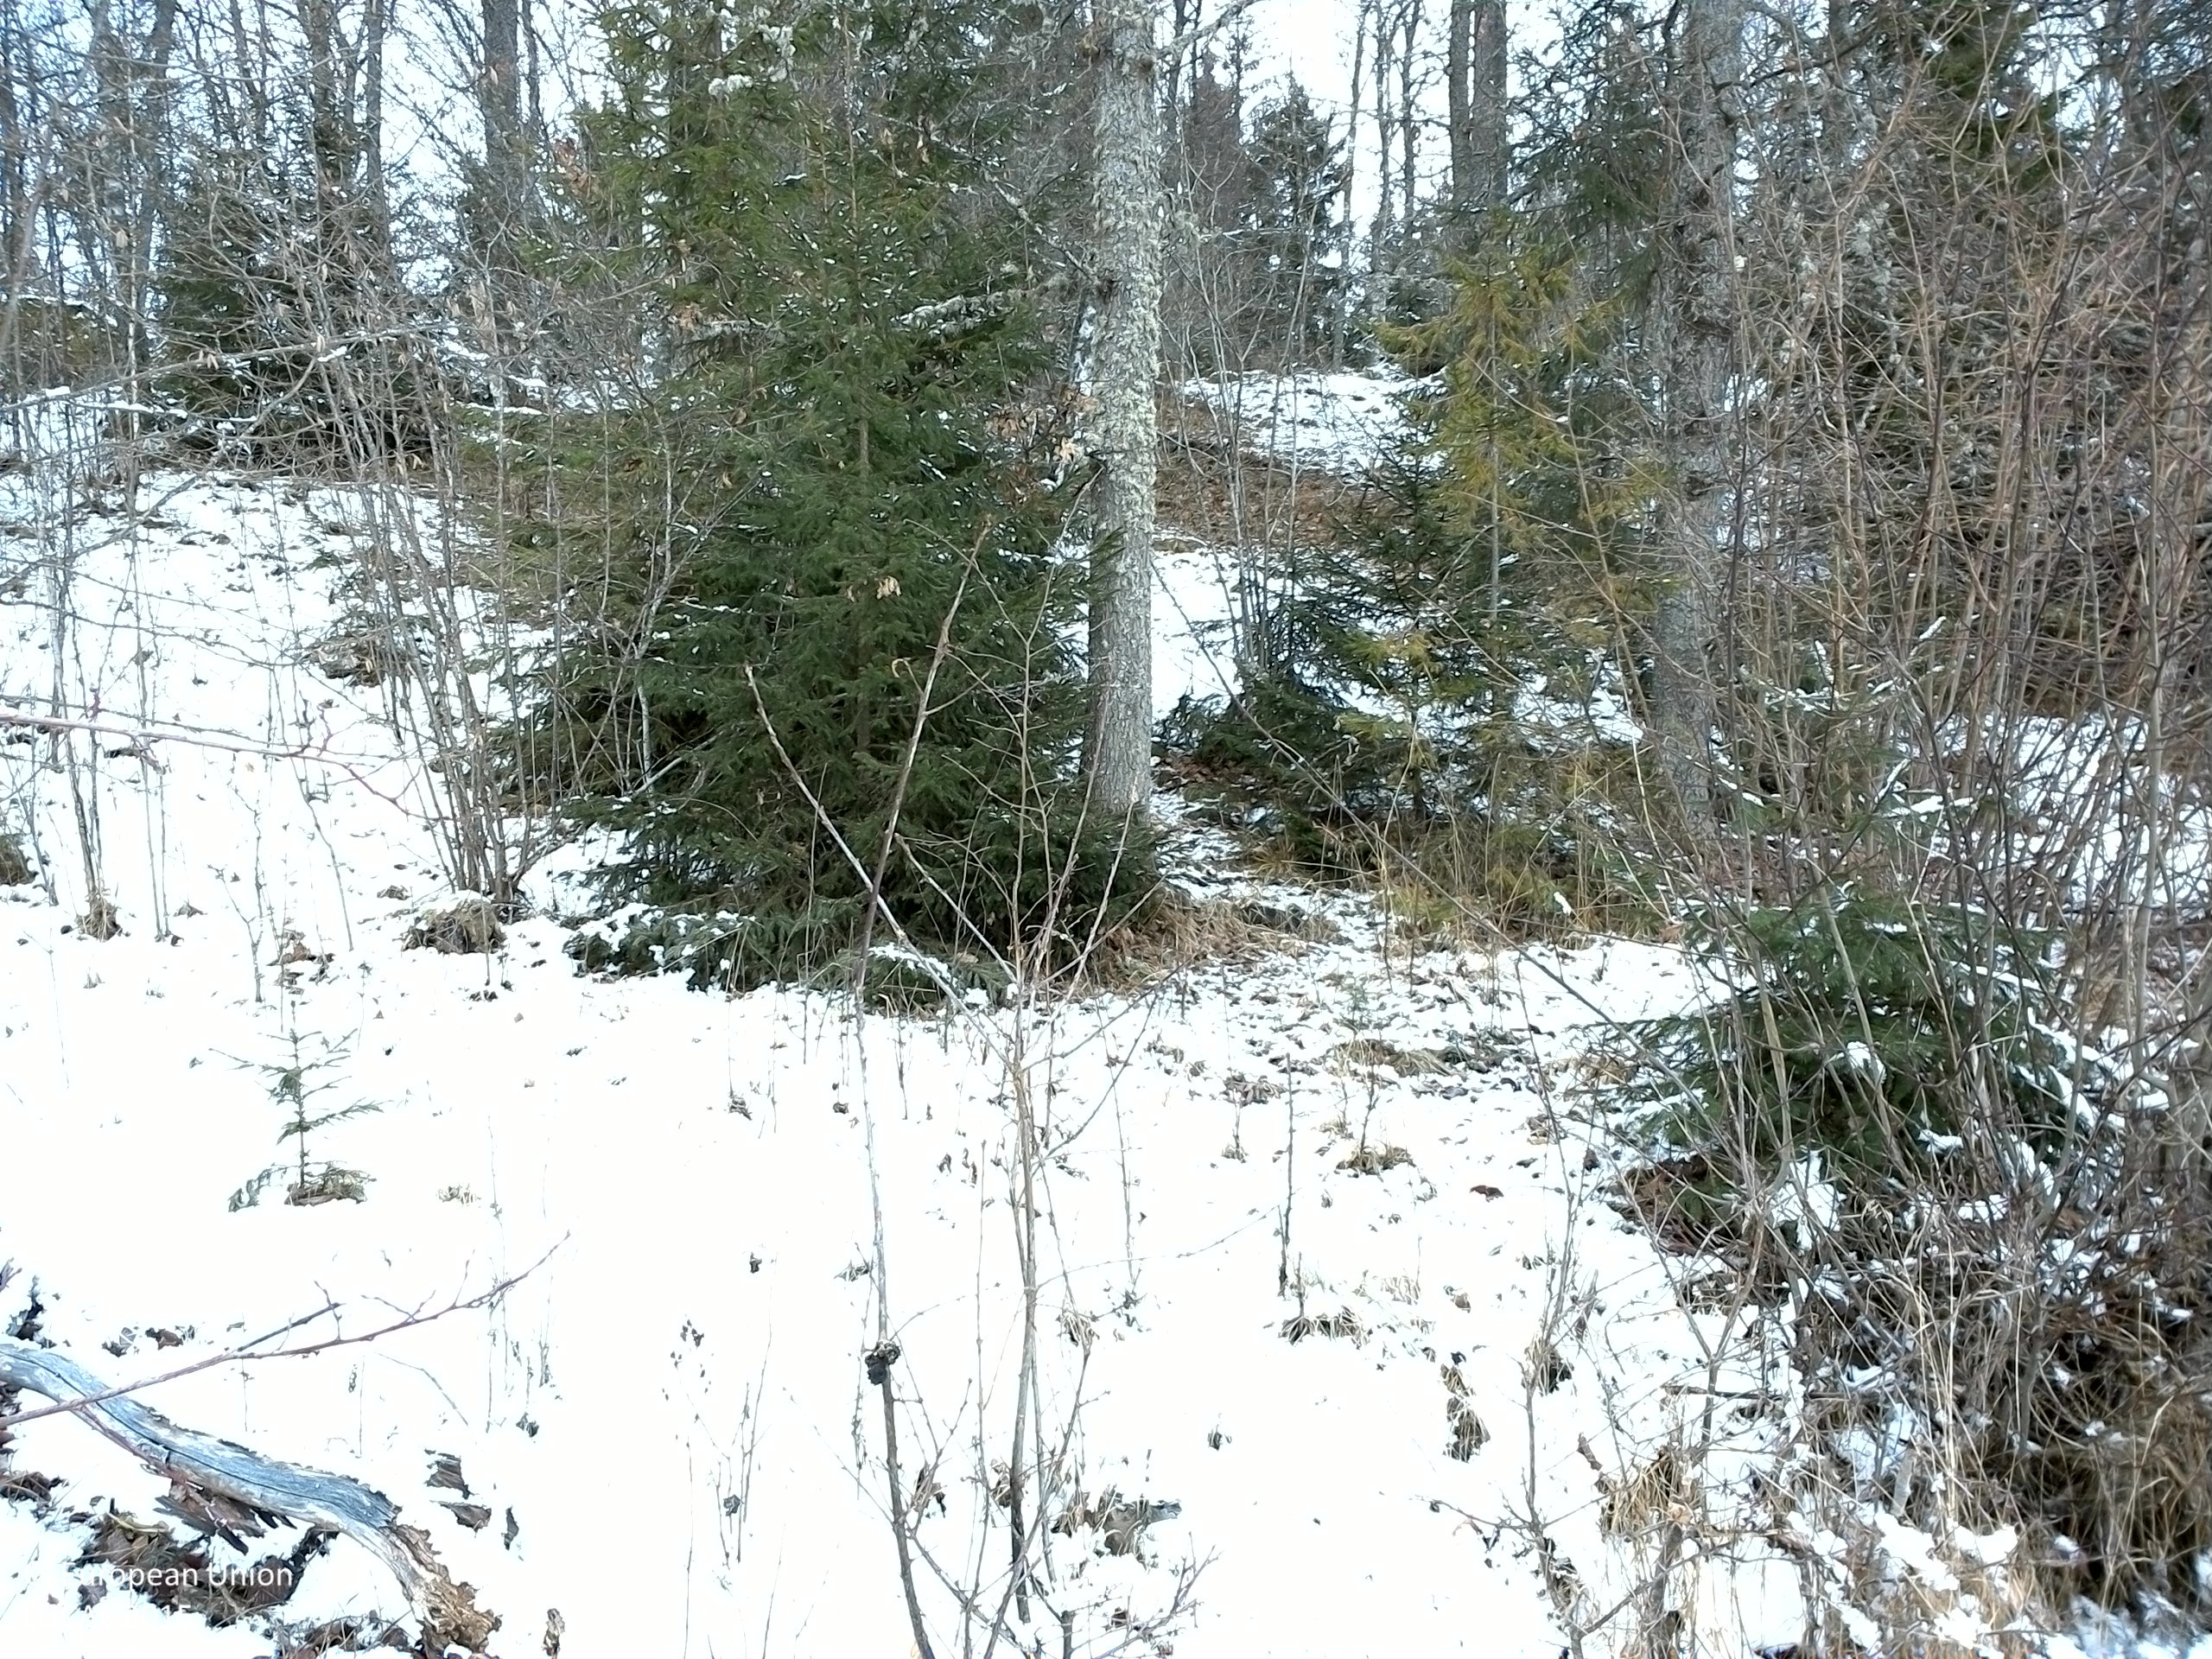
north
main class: Woodland
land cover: Broadleaved woodland
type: boreal forest
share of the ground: 50 - 75 %
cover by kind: broadleaved forest trees 50 %, herbaceous plants 20 %, coniferous forest trees 15 %, lichens and mosses 10 %, shrubs 5 %
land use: Forestry
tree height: > 5 m
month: December
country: SE
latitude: 59.5161
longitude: 16.3012
